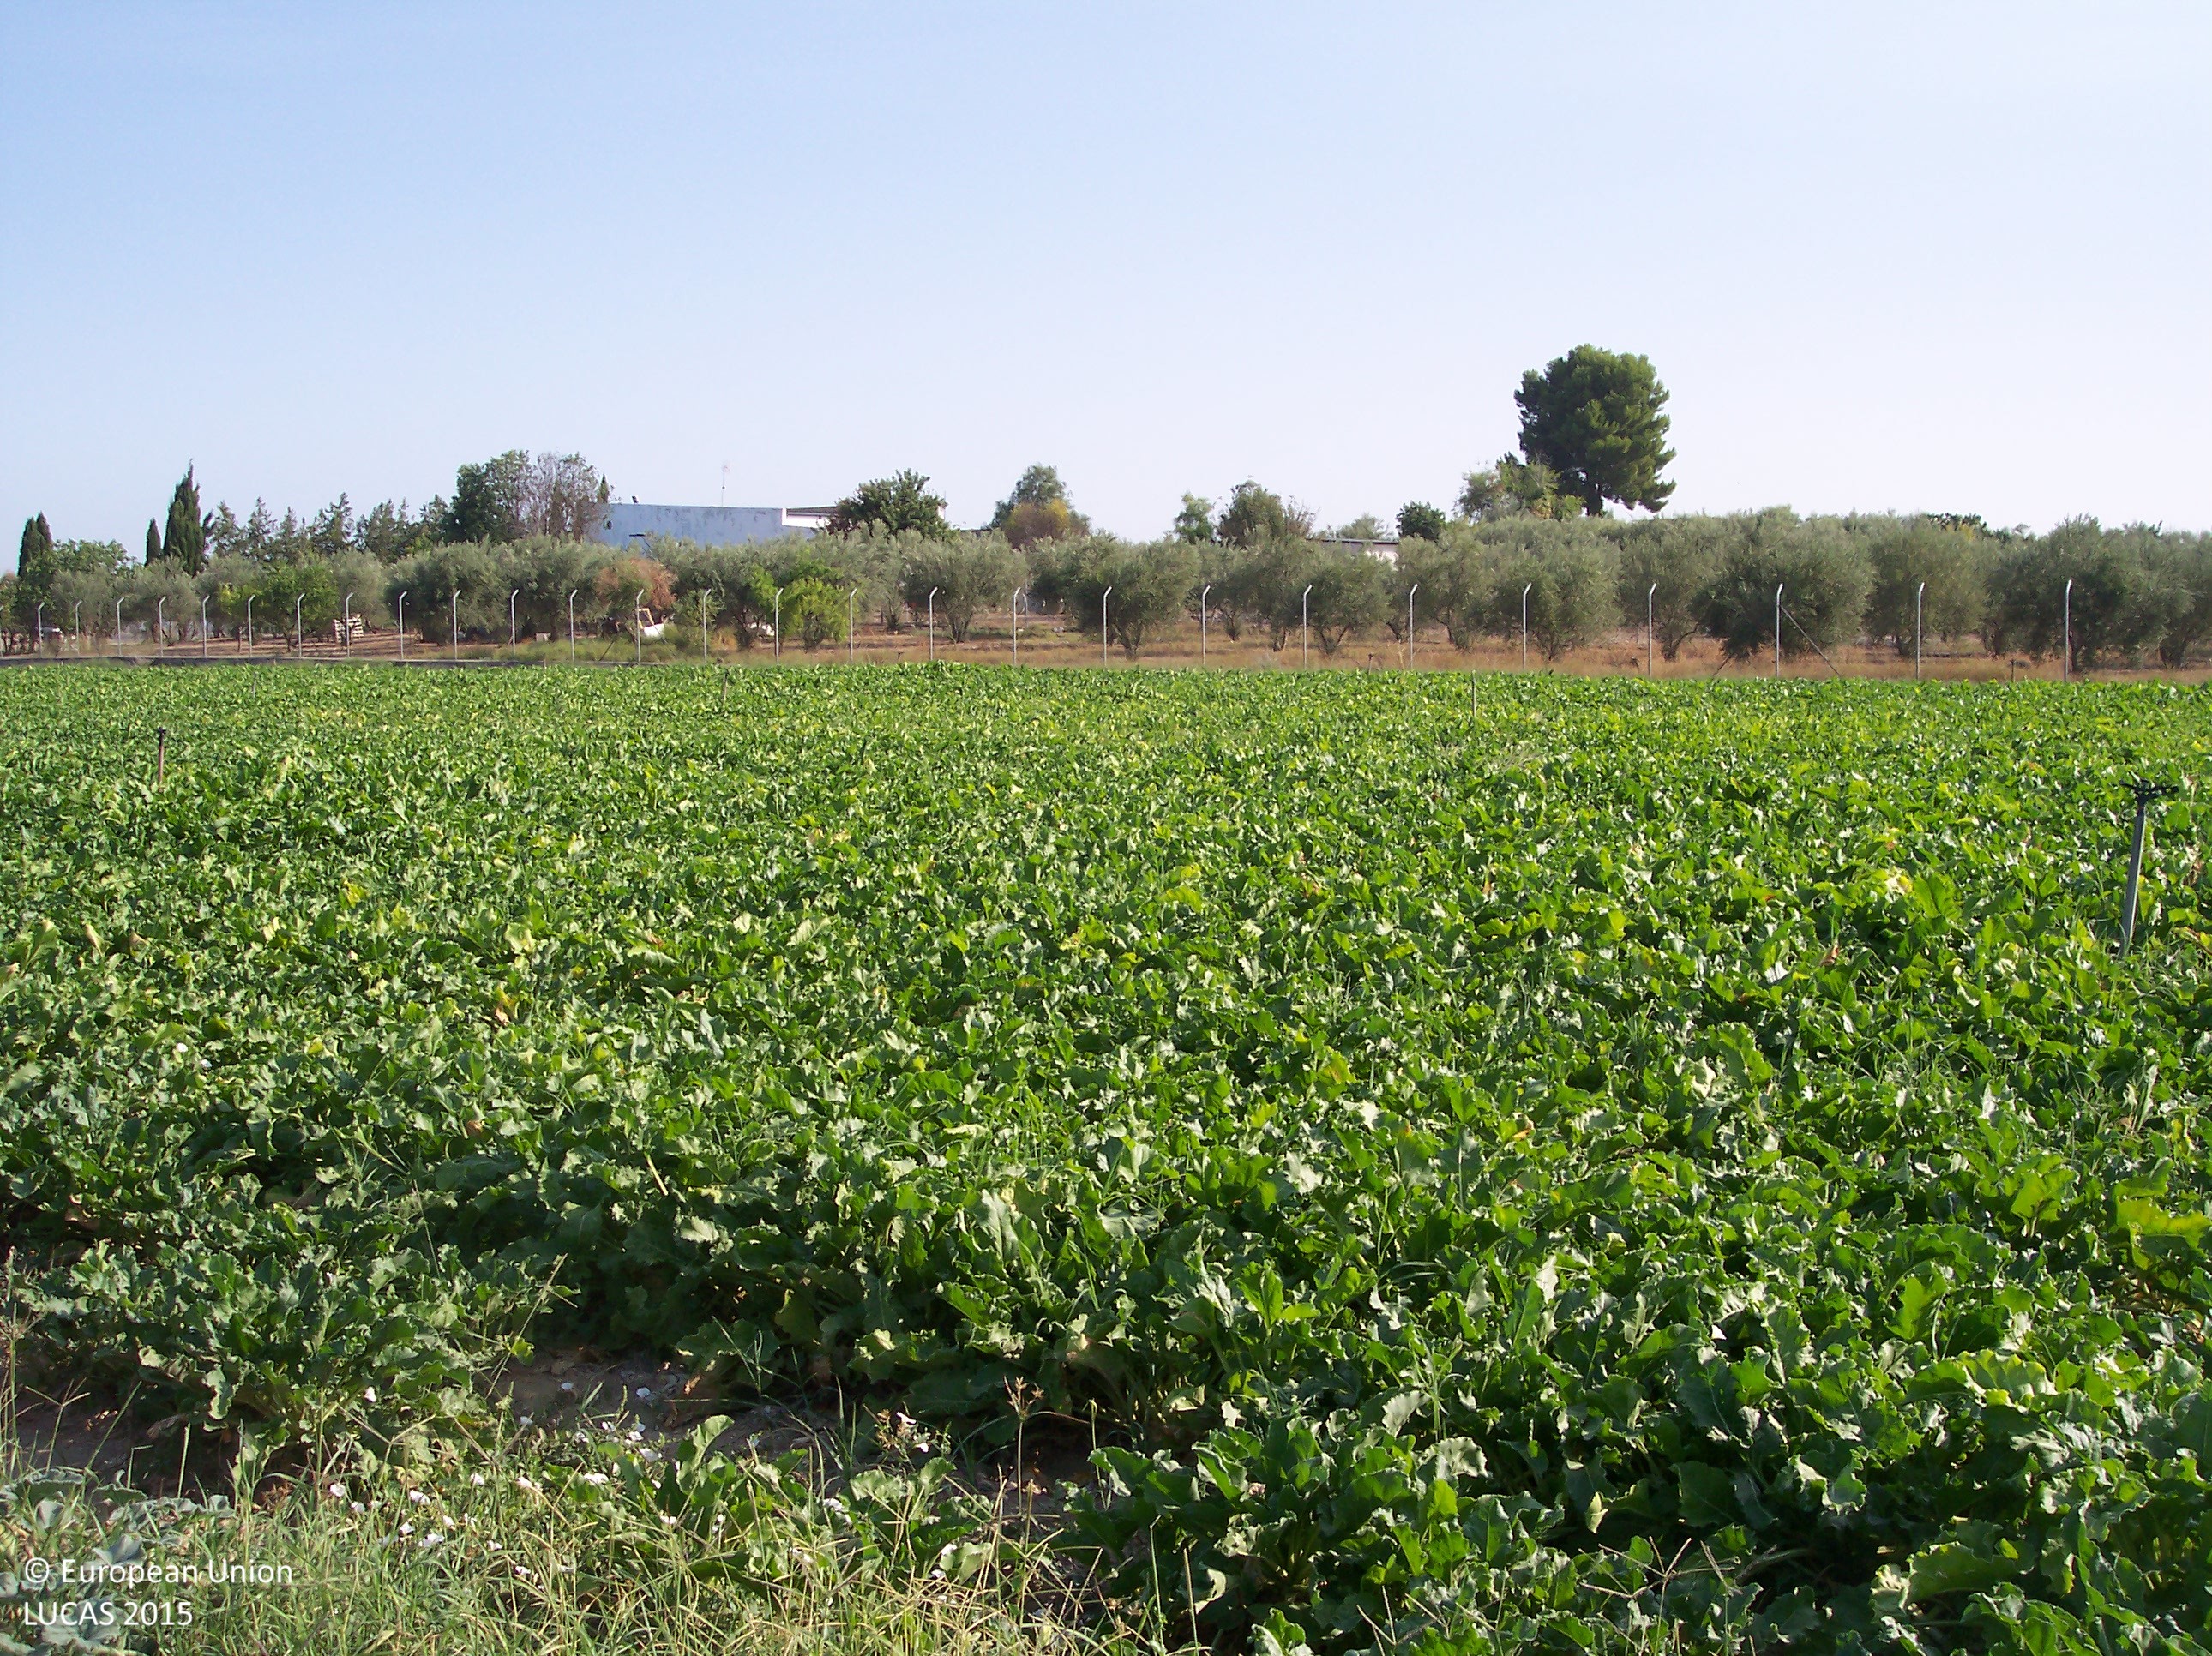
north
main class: Cropland
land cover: Cotton
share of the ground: > 75 %
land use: Agriculture (excluding fallow land and kitchen gardens)
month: July
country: ES
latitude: 37.0603
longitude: -5.8151
